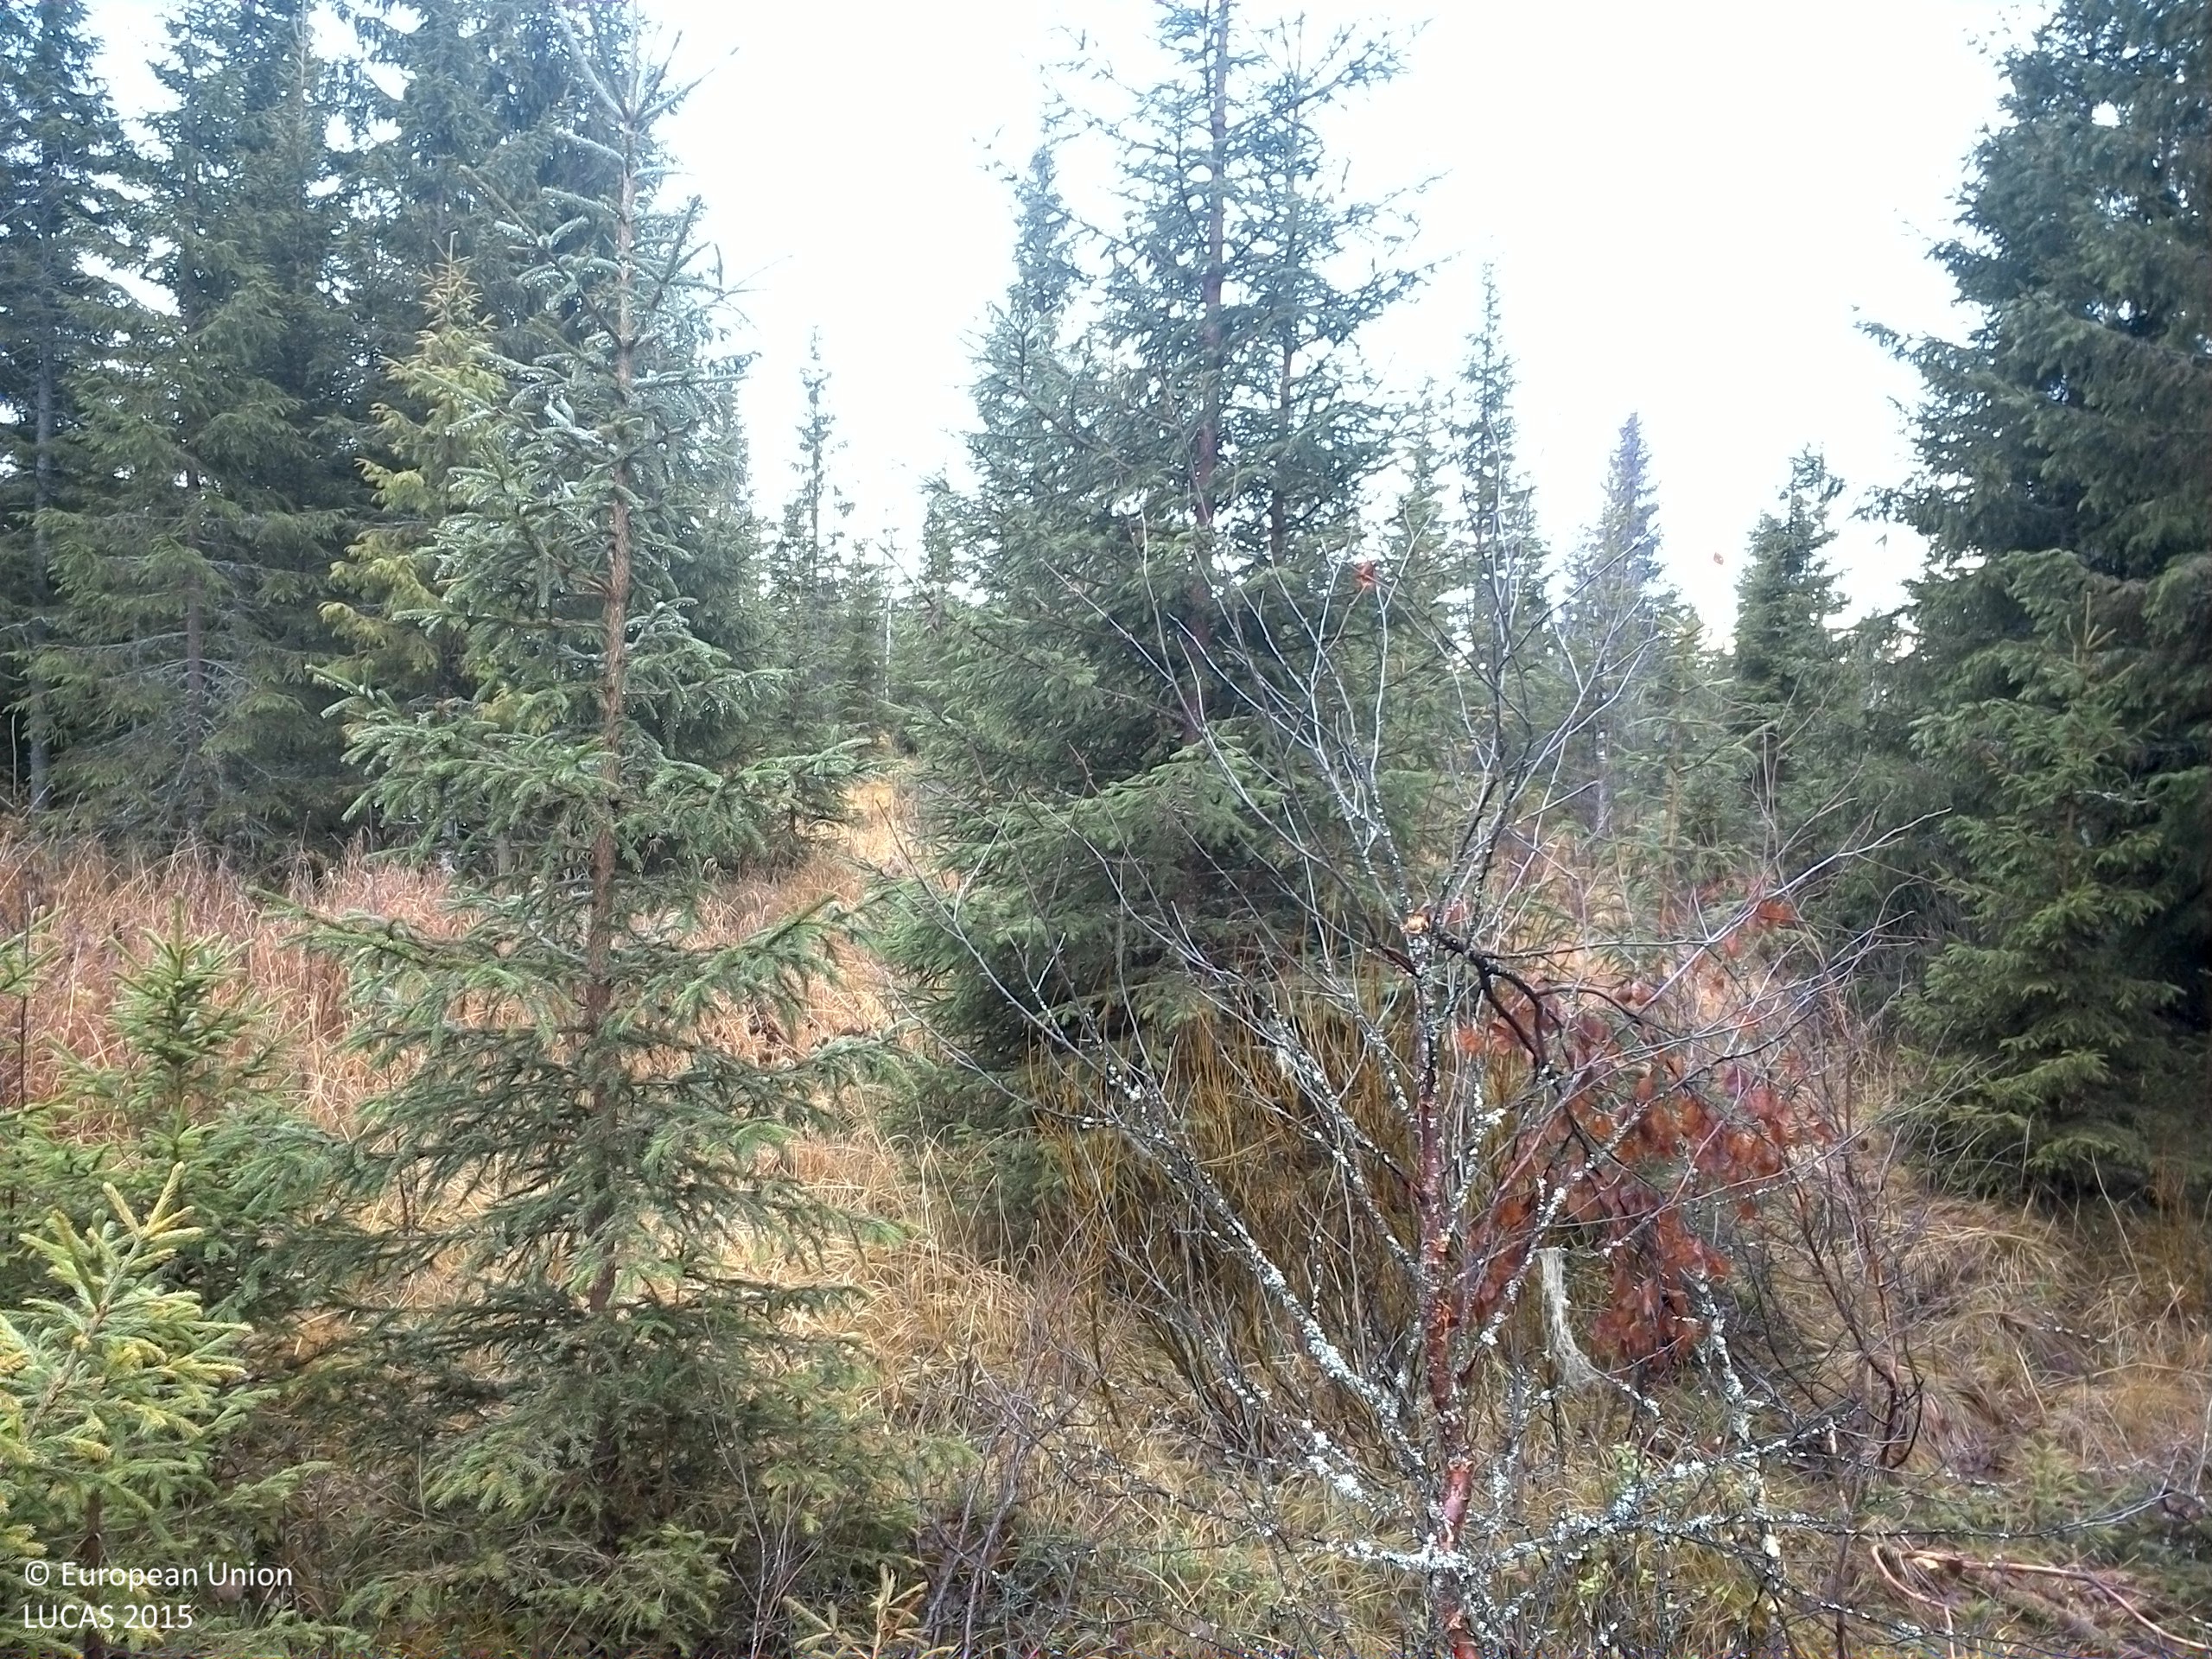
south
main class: Woodland
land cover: Spruce dominated mixed woodland
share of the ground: 10 - 25 %
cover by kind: lichens and mosses 30 %, shrubs 25 %, herbaceous plants 15 %, unconsolidated bare surface 15 %, coniferous forest trees 10 %, broadleaved forest trees 5 %
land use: Forestry
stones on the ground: 25 - 50 %
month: October
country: SE
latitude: 63.7885
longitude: 15.1897
